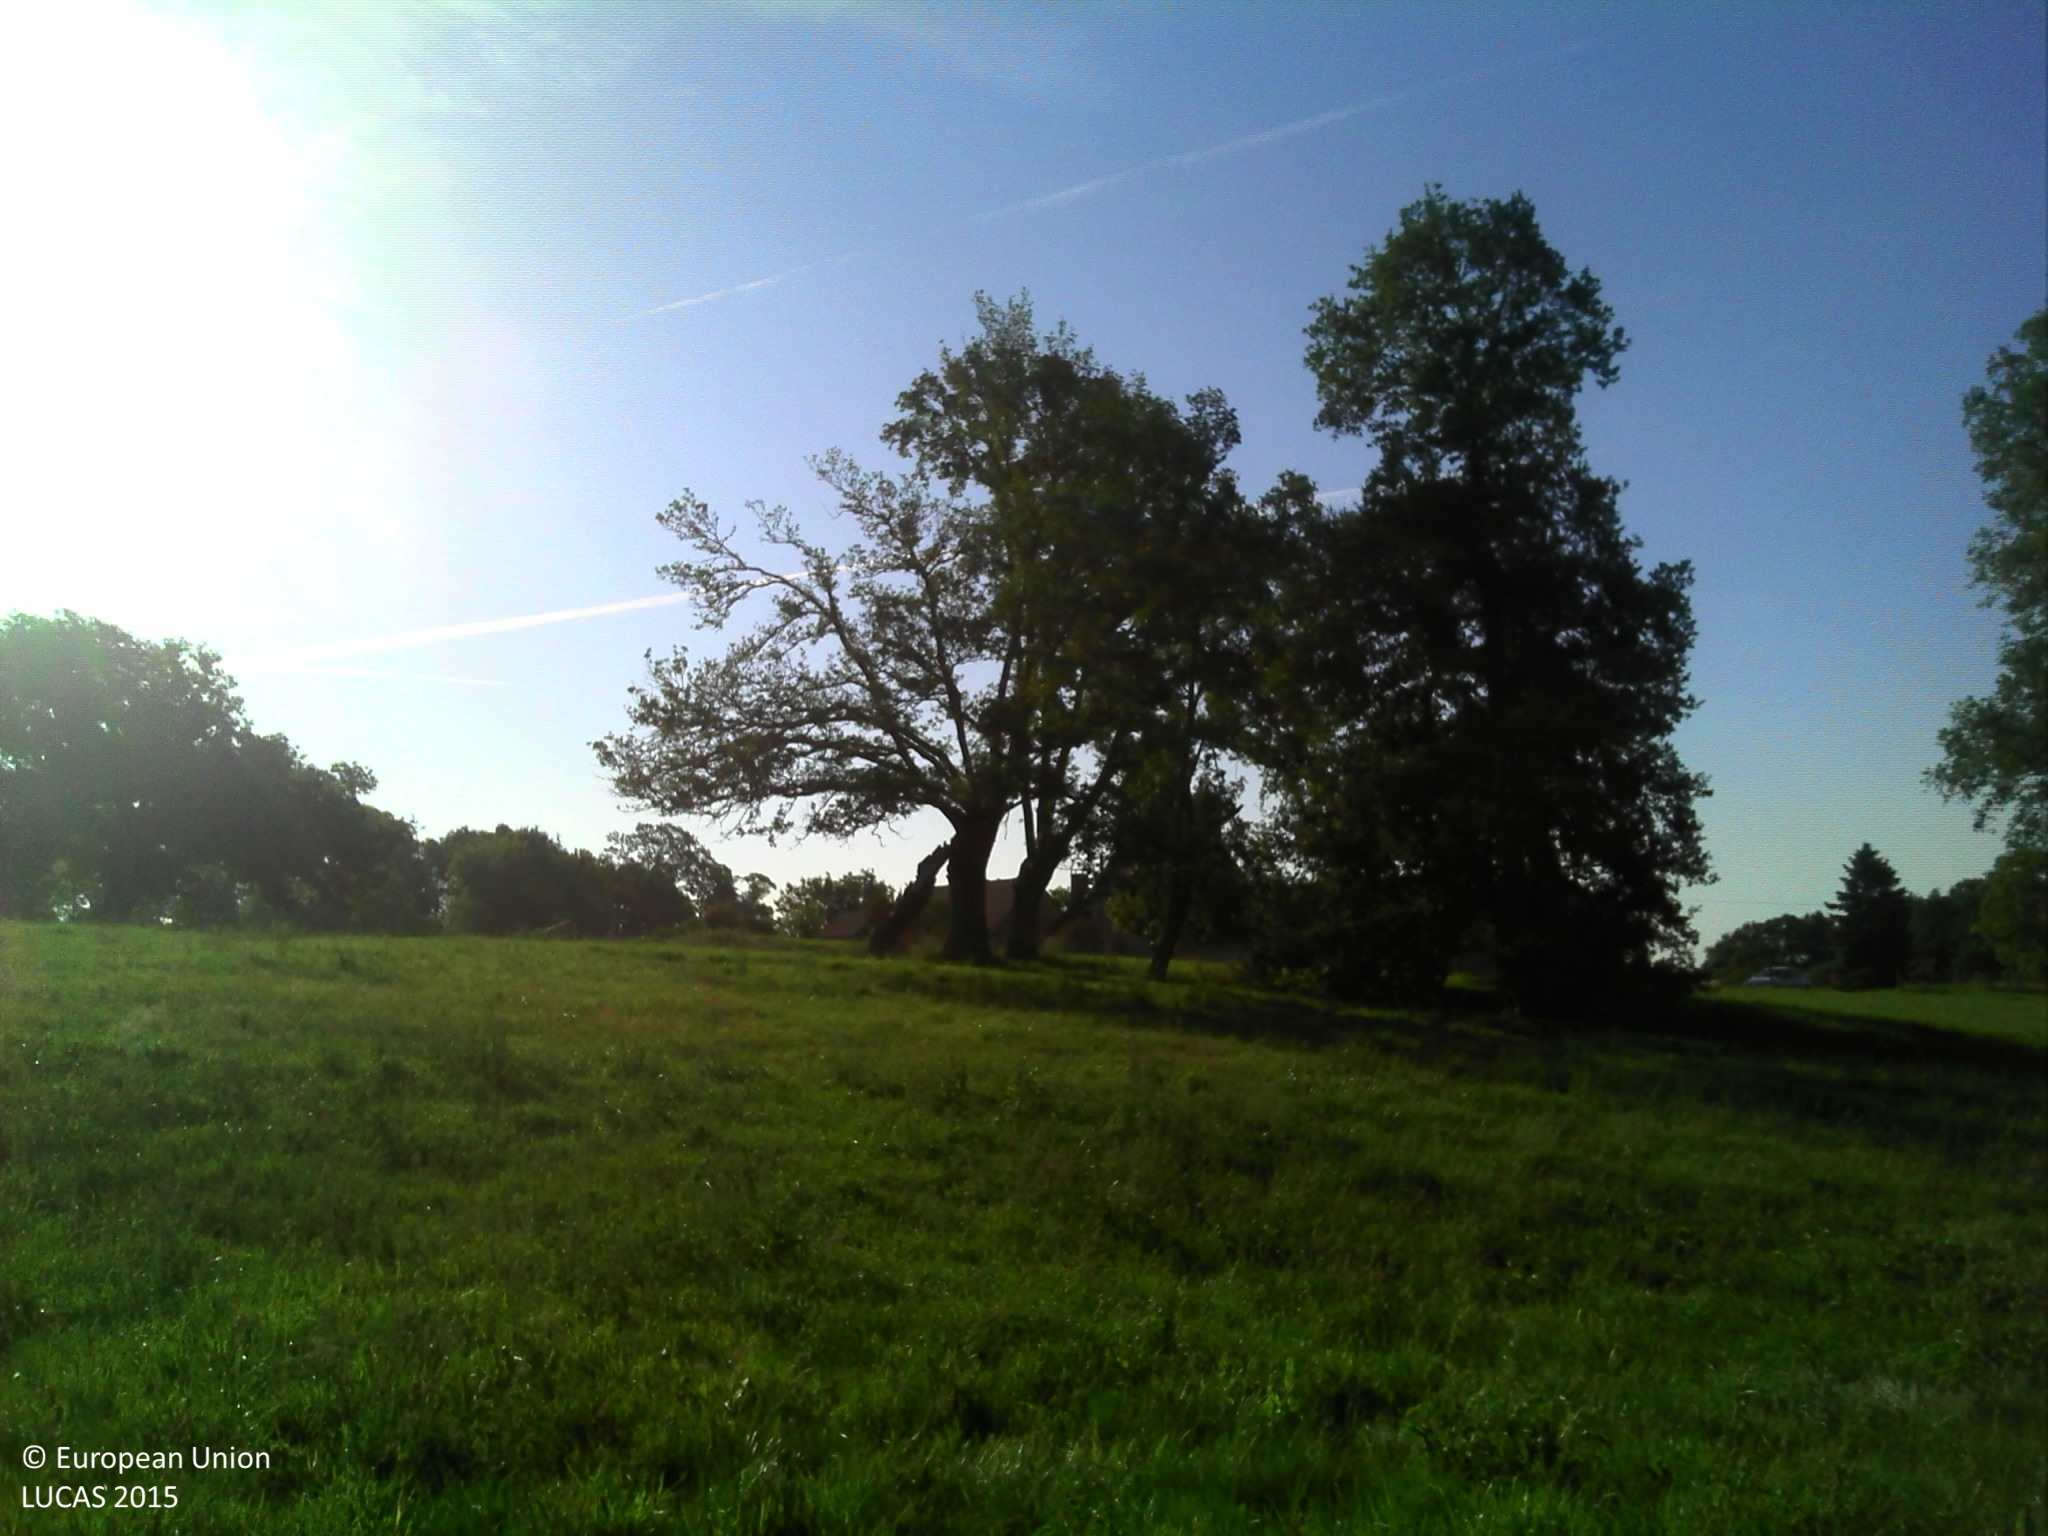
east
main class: Grassland
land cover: Grassland without tree/shrub cover
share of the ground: > 75 %
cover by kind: herbaceous plants 100 %
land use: Agriculture (excluding fallow land and kitchen gardens)
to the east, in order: Grassland without tree/shrub cover; Single bushes/trees; Grassland without tree/shrub cover; Lines of trees; Broadleaved woodland
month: June
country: FR
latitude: 48.0200
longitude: -0.0170
